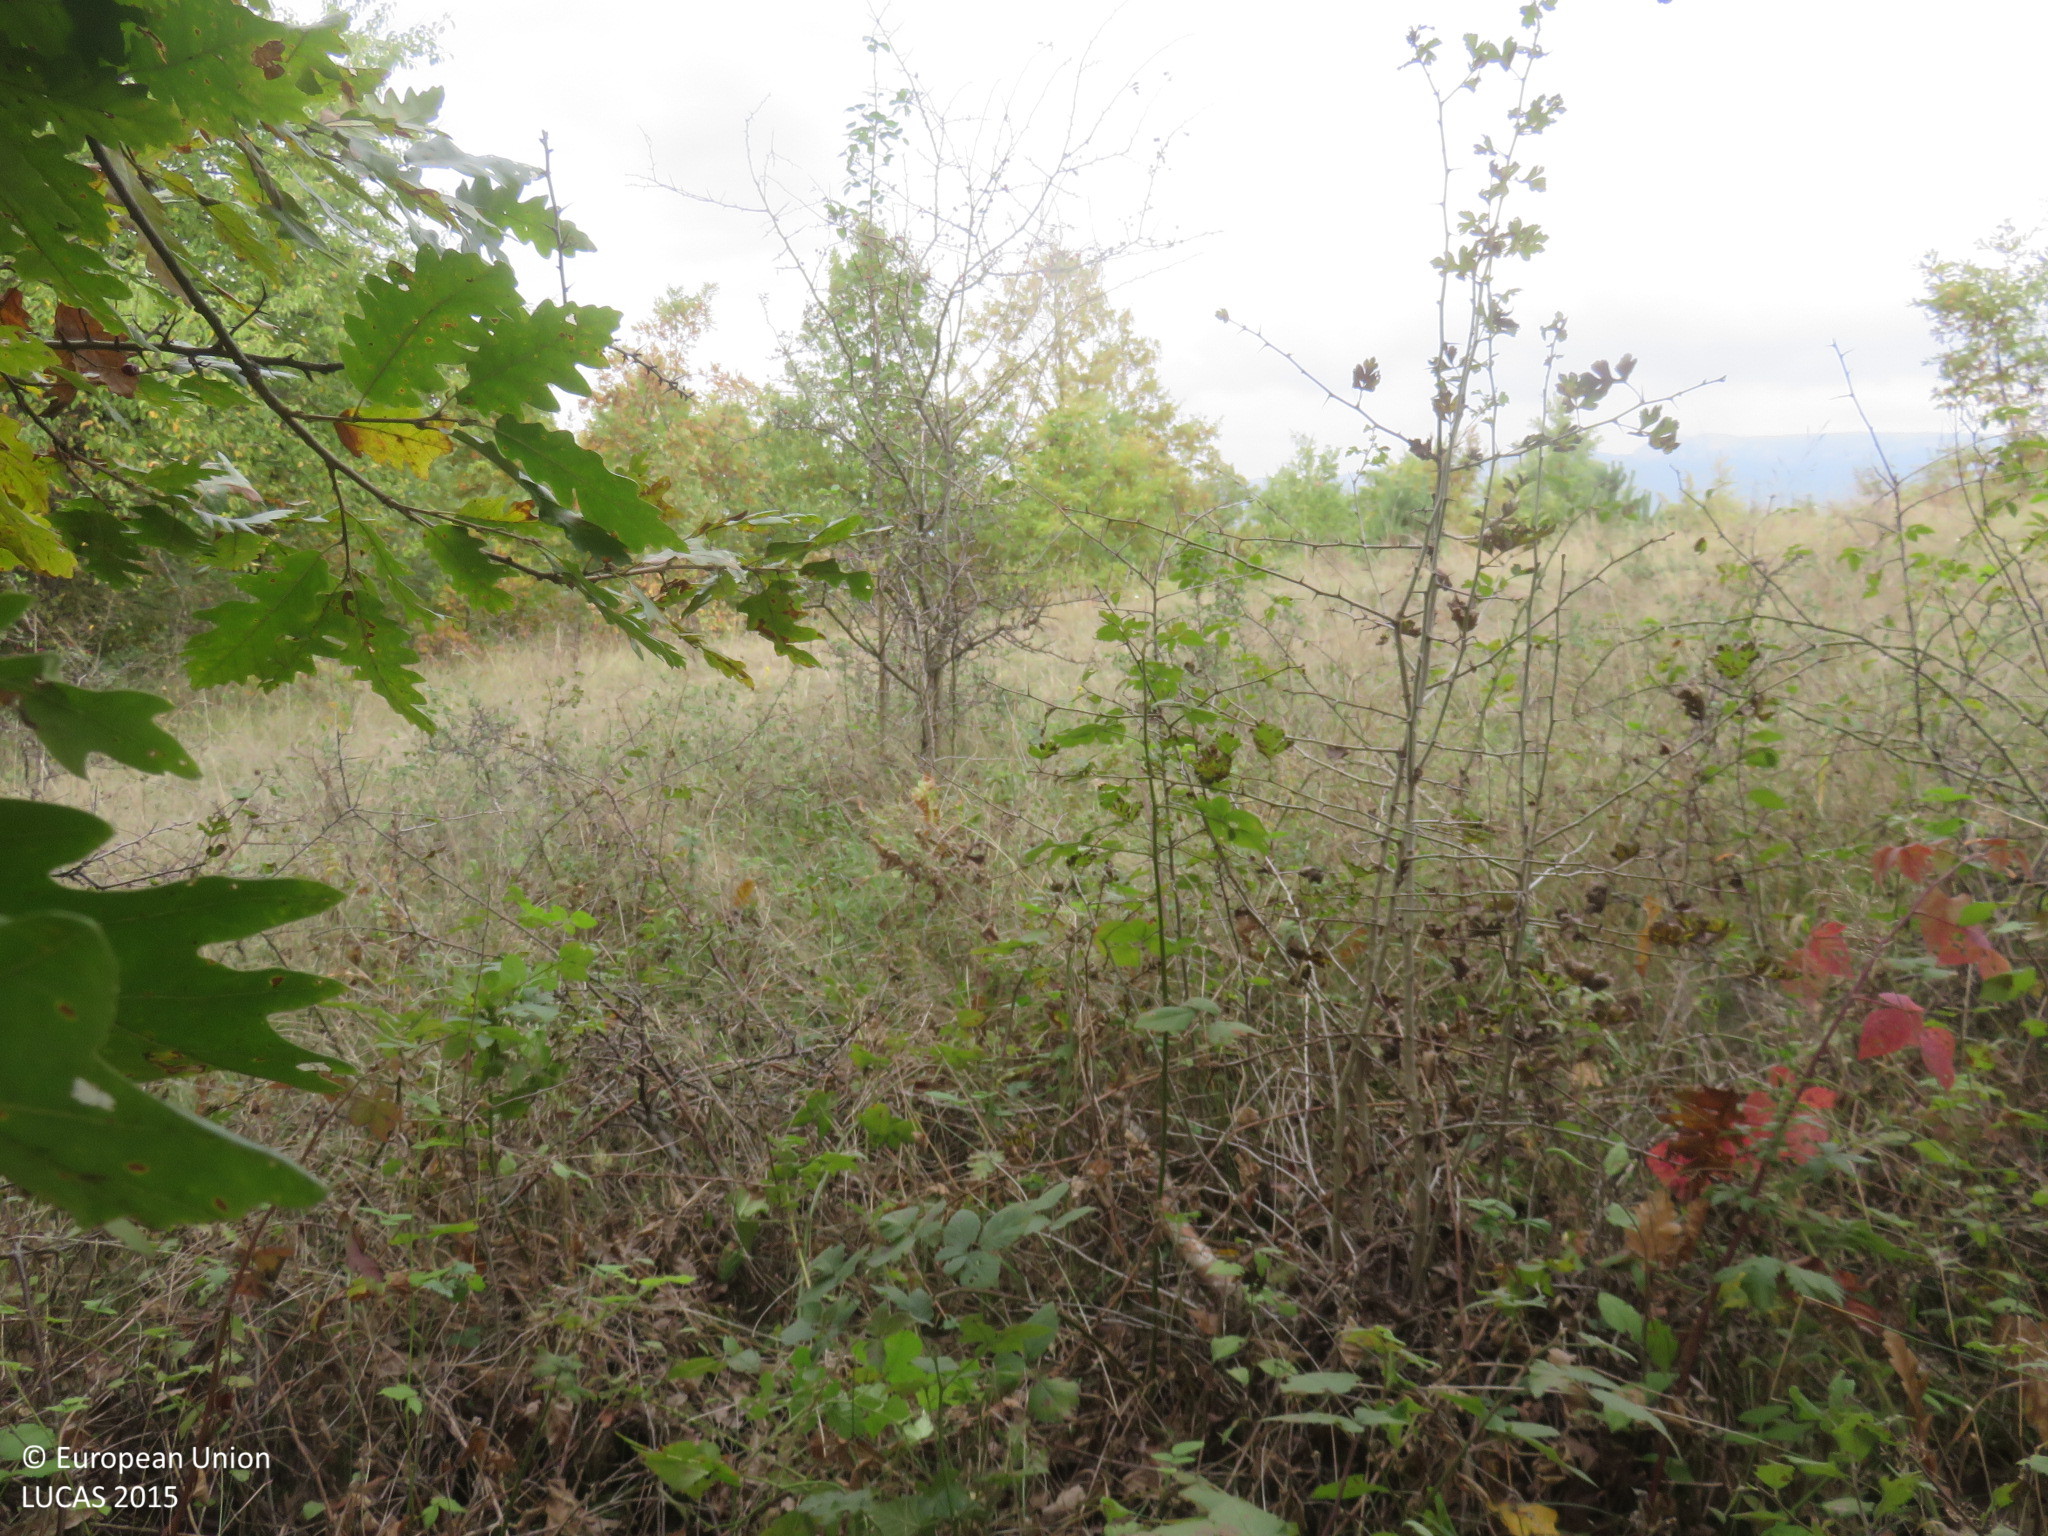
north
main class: Woodland
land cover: Broadleaved woodland
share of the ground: > 75 %
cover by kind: broadleaved forest trees 90 %, shrubs 5 %, herbaceous plants 5 %
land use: Semi-natural and natural areas not in use
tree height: < 5 m
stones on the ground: < 10 %
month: October
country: BG
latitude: 42.9119
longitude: 25.1966
